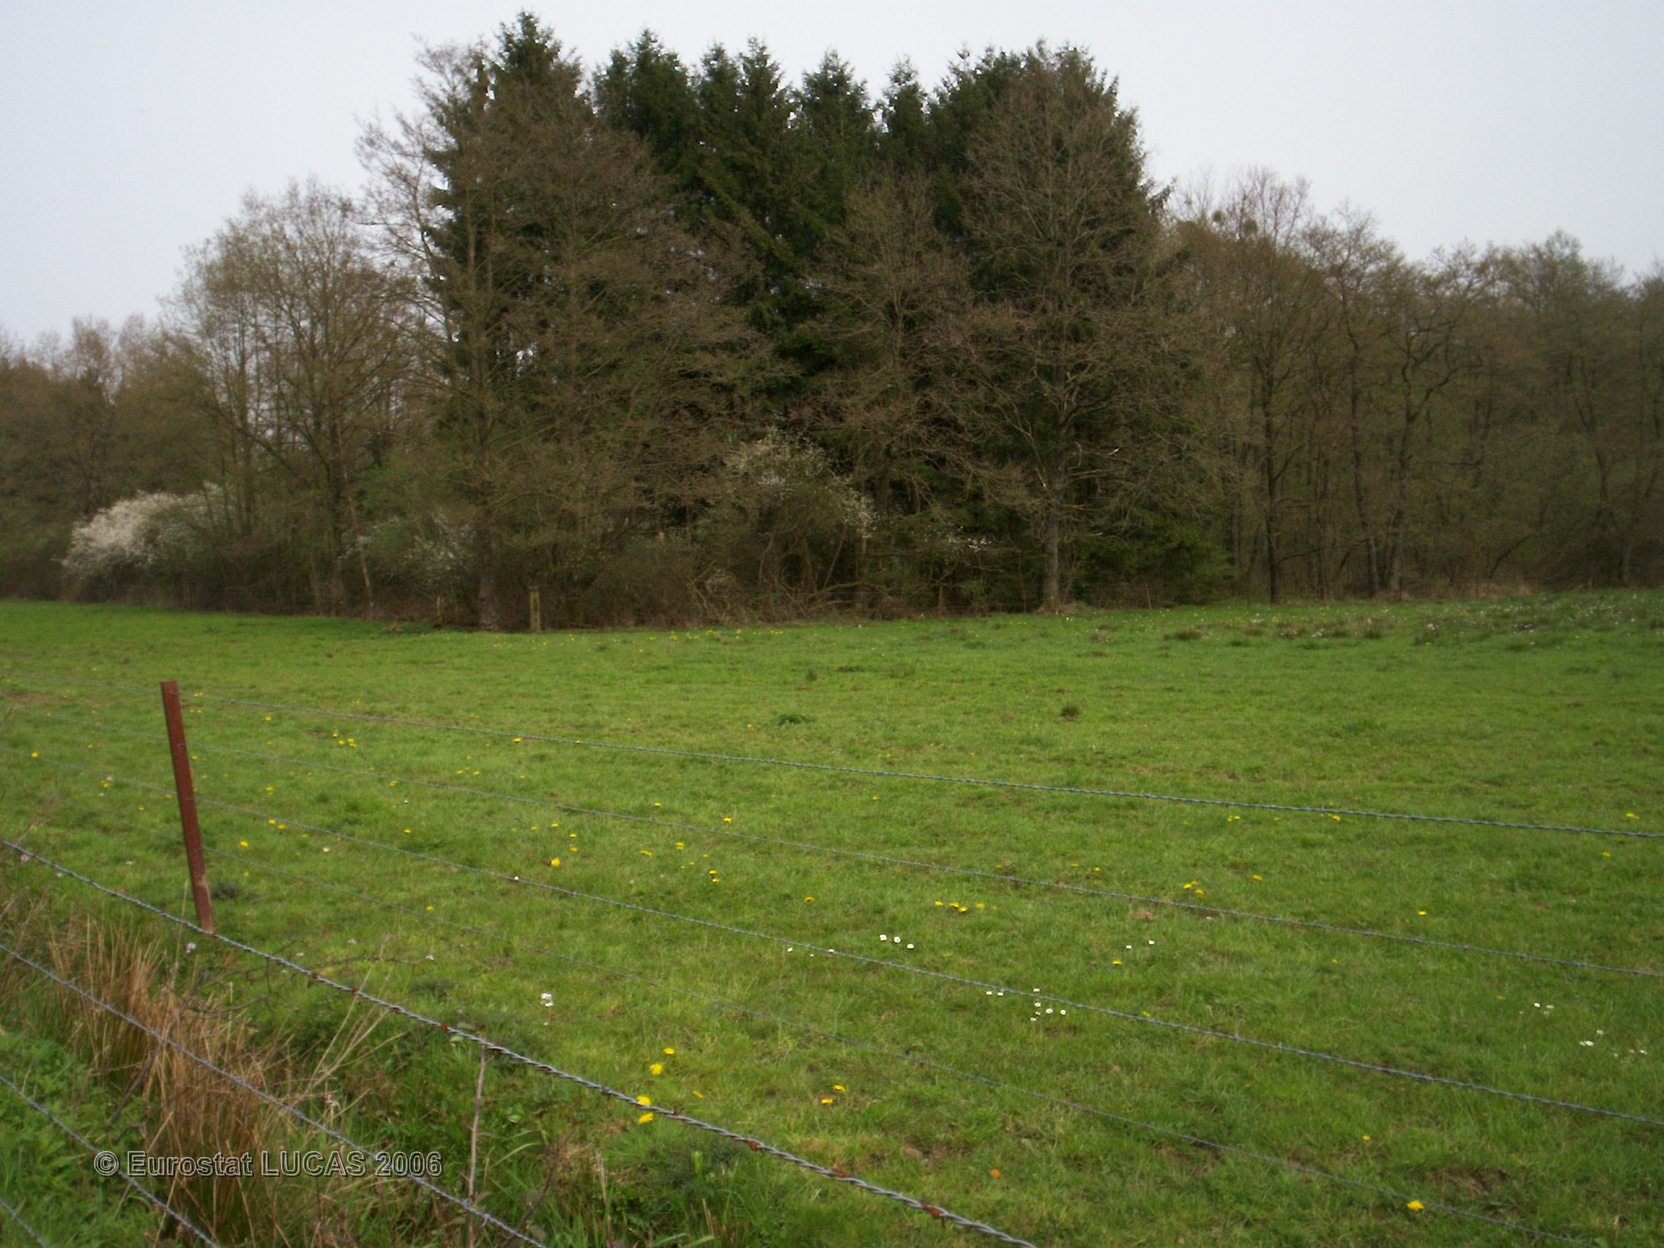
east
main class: Grassland
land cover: Grassland without tree/shrub cover
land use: Agriculture (excluding fallow land and kitchen gardens)
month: May
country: FR
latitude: 49.8659
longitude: 4.3891
